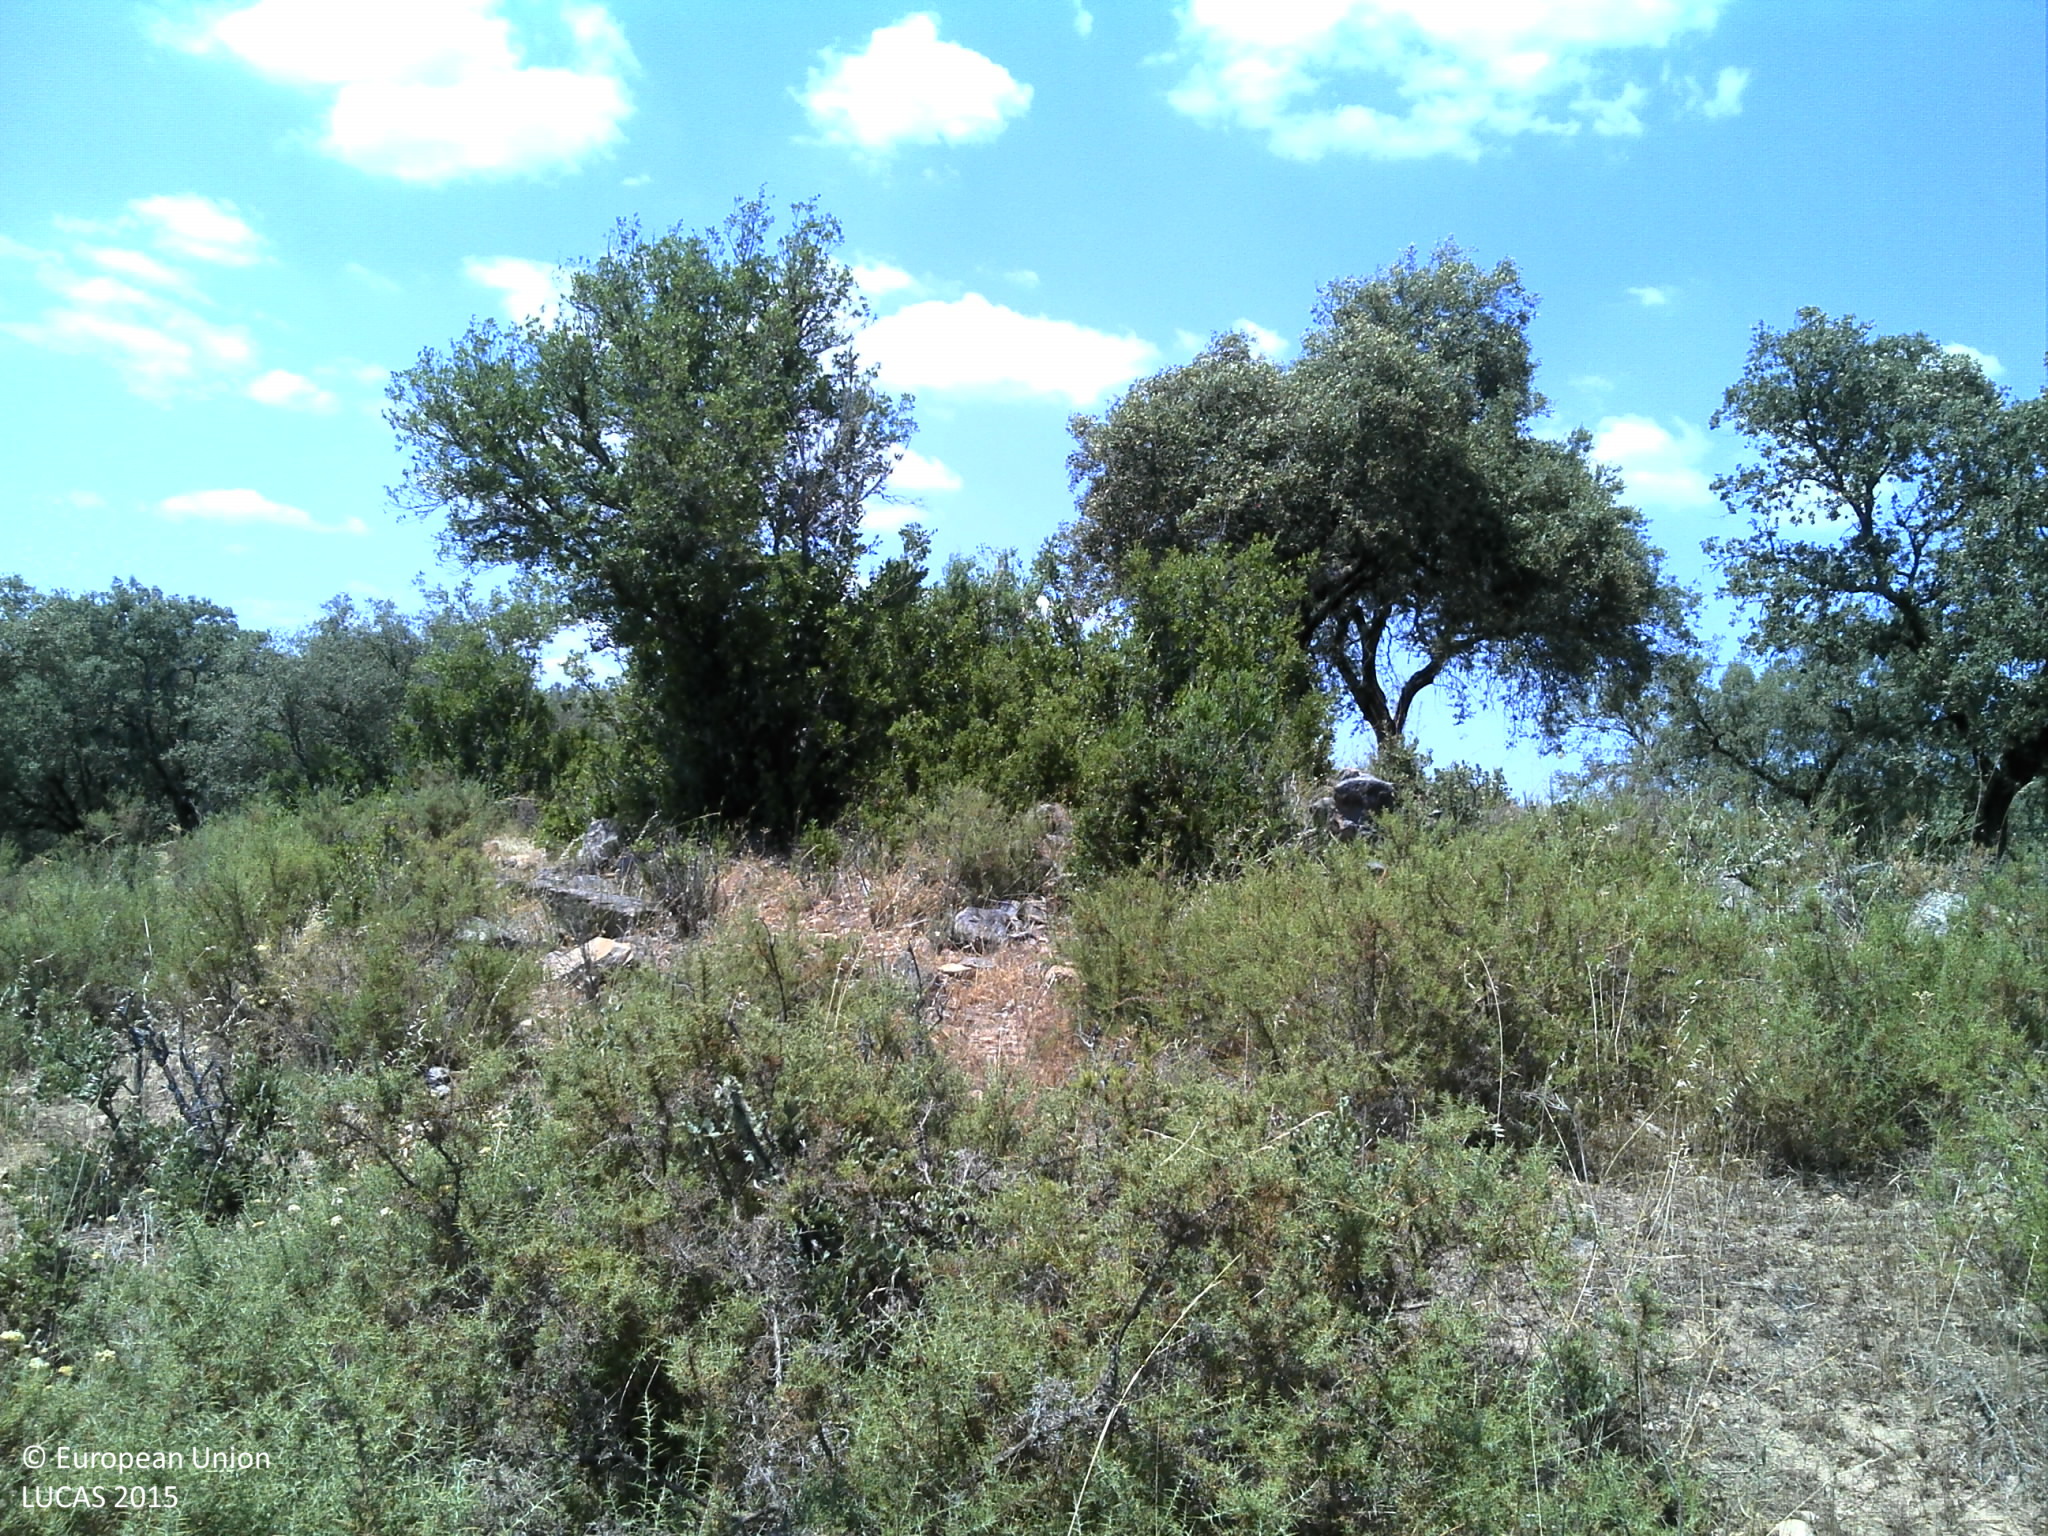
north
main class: Woodland
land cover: Broadleaved woodland
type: broadleaved evergreen forest
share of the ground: 25 - 50 %
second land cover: Shrubland without tree cover
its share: 25 - 50 %
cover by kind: shrubs 50 %, broadleaved forest trees 25 %, unconsolidated bare surface 15 %, herbaceous plants 10 %
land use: Forestry
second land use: Agriculture (excluding fallow land and kitchen gardens)
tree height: > 5 m
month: June
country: PT
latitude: 38.4239
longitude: -8.1754
